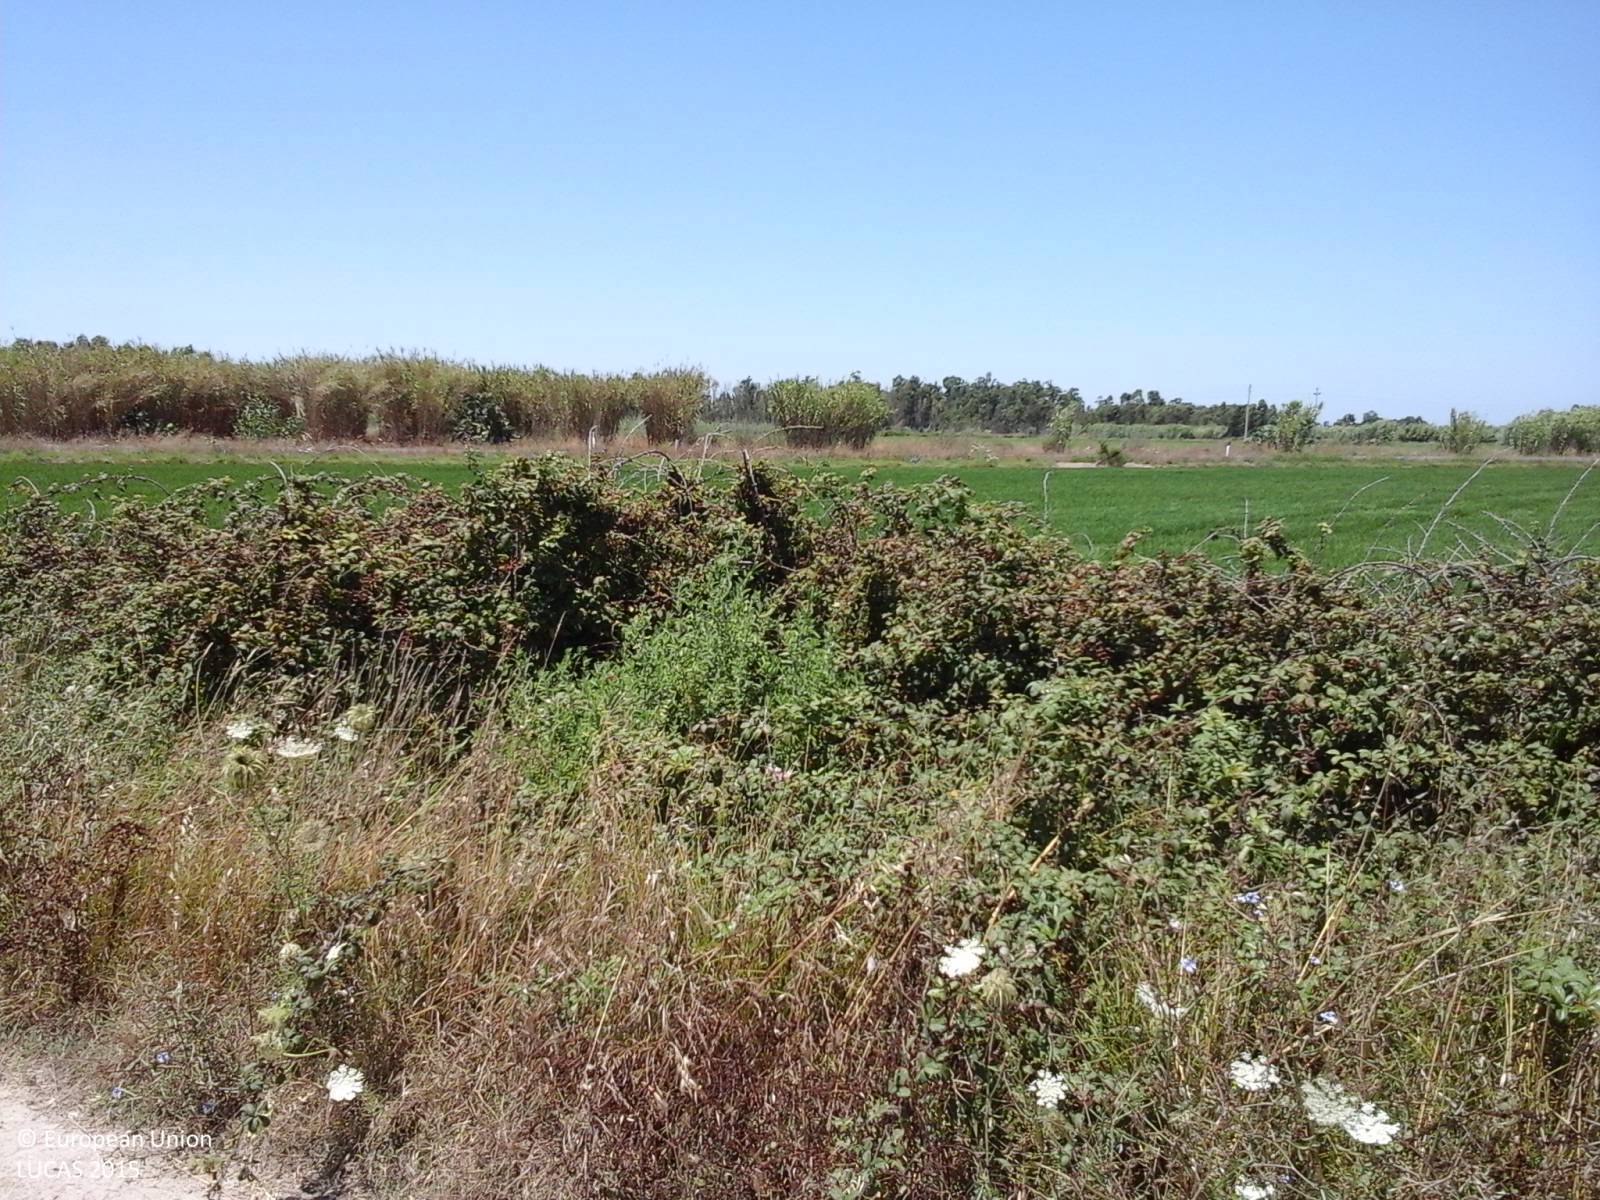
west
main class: Cropland
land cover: Rice
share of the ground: > 75 %
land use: Agriculture (excluding fallow land and kitchen gardens)
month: July
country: IT
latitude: 39.9494
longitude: 8.5915
